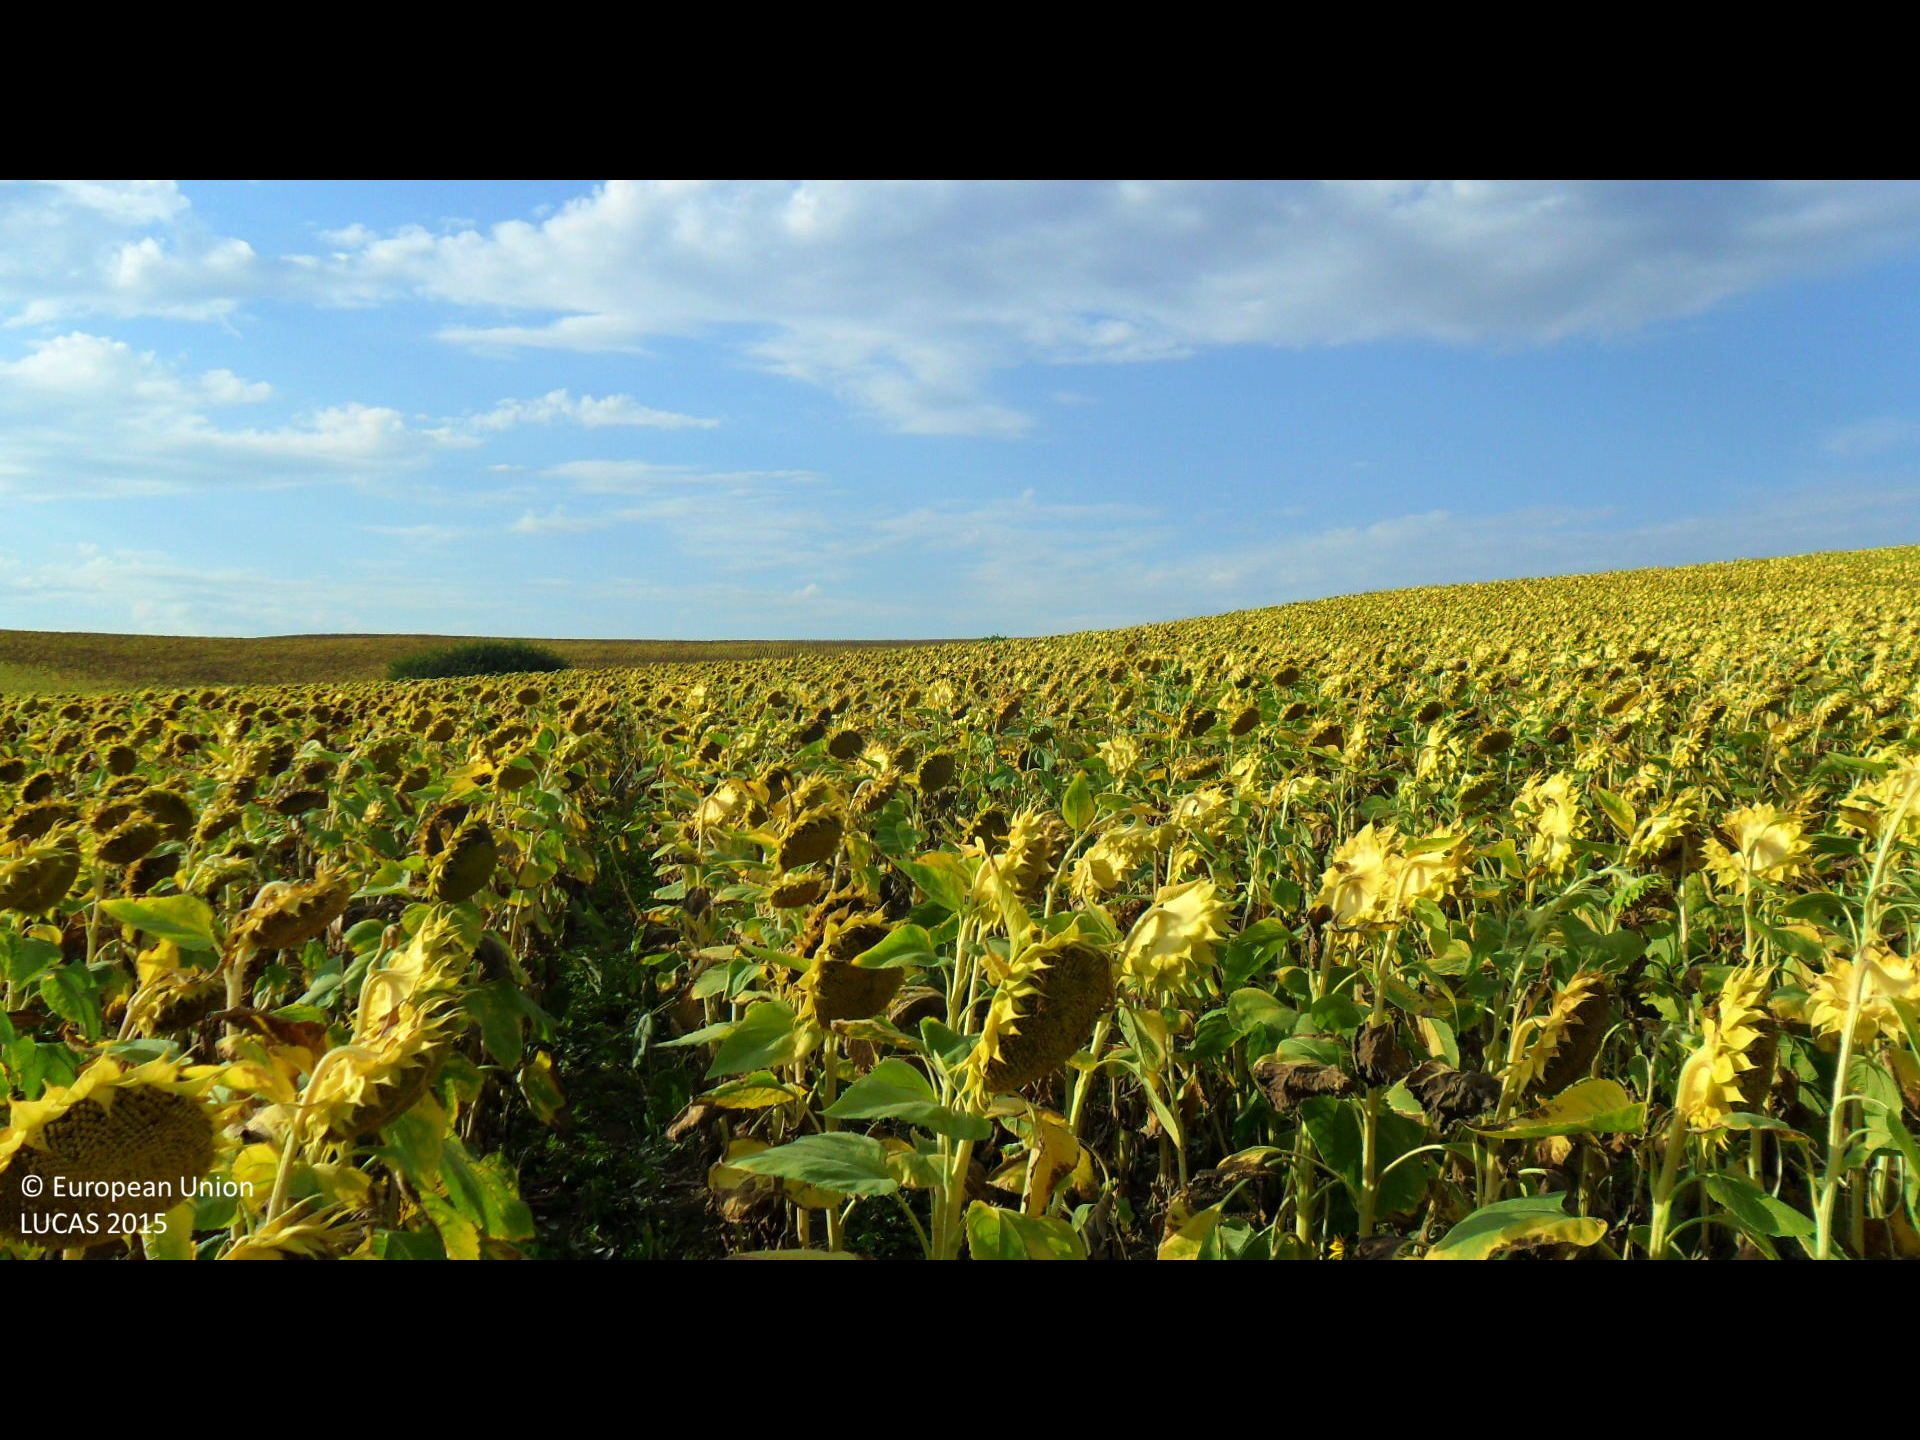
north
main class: Cropland
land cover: Sunflower
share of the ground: > 75 %
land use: Agriculture (excluding fallow land and kitchen gardens)
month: August
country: BG
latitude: 43.3692
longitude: 26.1502
